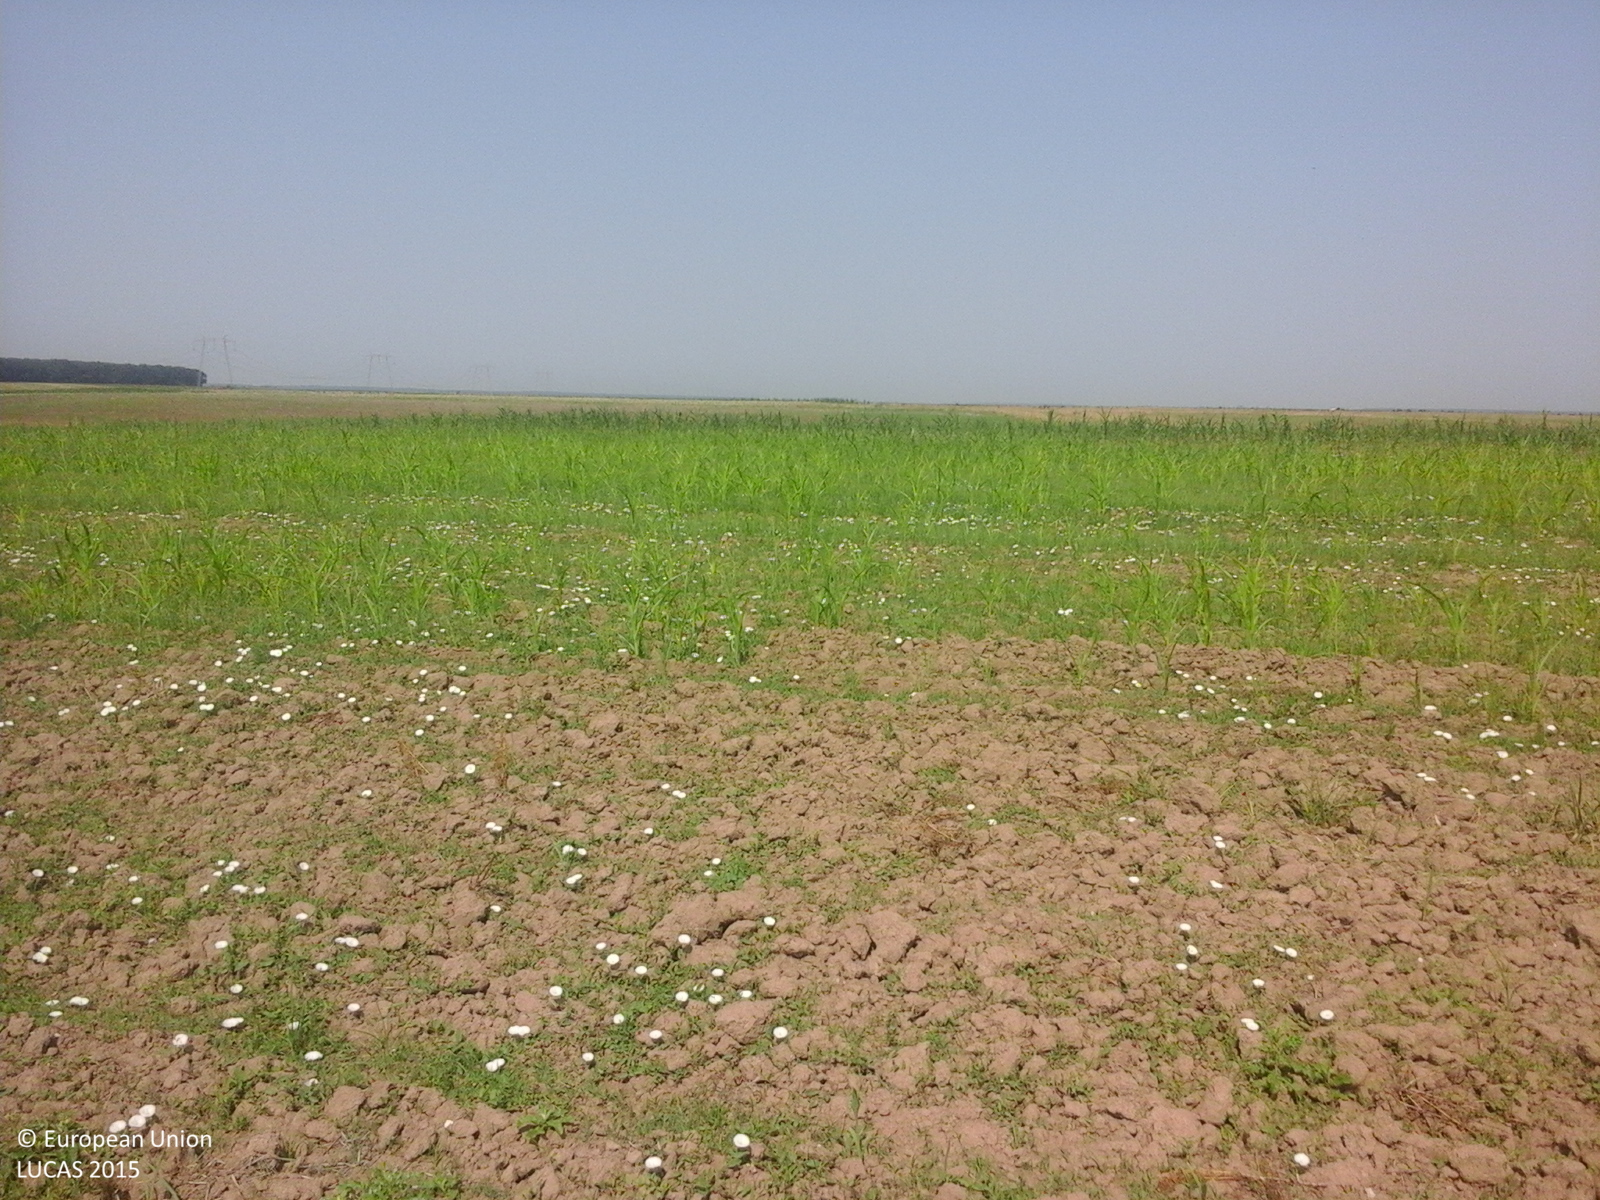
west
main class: Grassland
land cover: Spontaneously vegetated surfaces
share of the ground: < 10 %
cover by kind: herbaceous plants 100 %
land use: Fallow land
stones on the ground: < 10 %
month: July
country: RO
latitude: 44.5194
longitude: 25.4782
